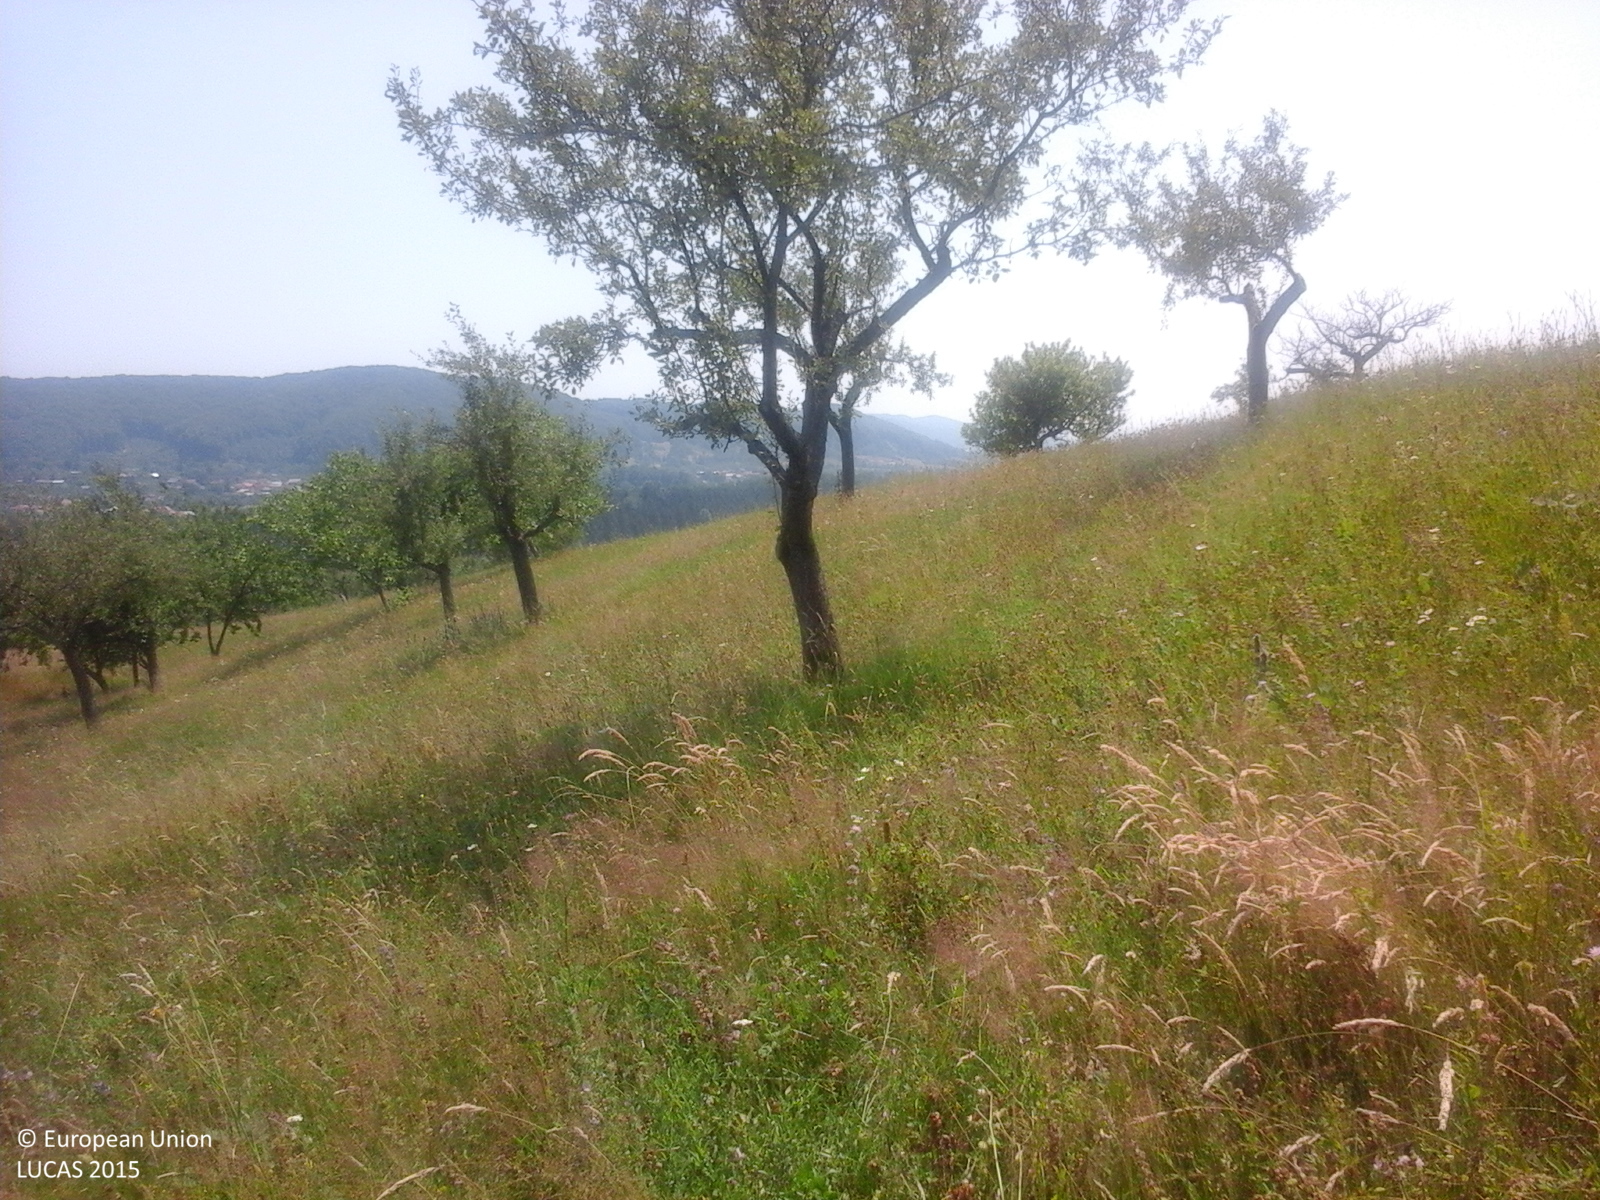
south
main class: Cropland
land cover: Apple fruit
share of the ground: 50 - 75 %
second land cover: Grassland without tree/shrub cover
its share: > 75 %
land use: Agriculture (excluding fallow land and kitchen gardens)
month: July
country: RO
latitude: 45.2062
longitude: 24.9179
